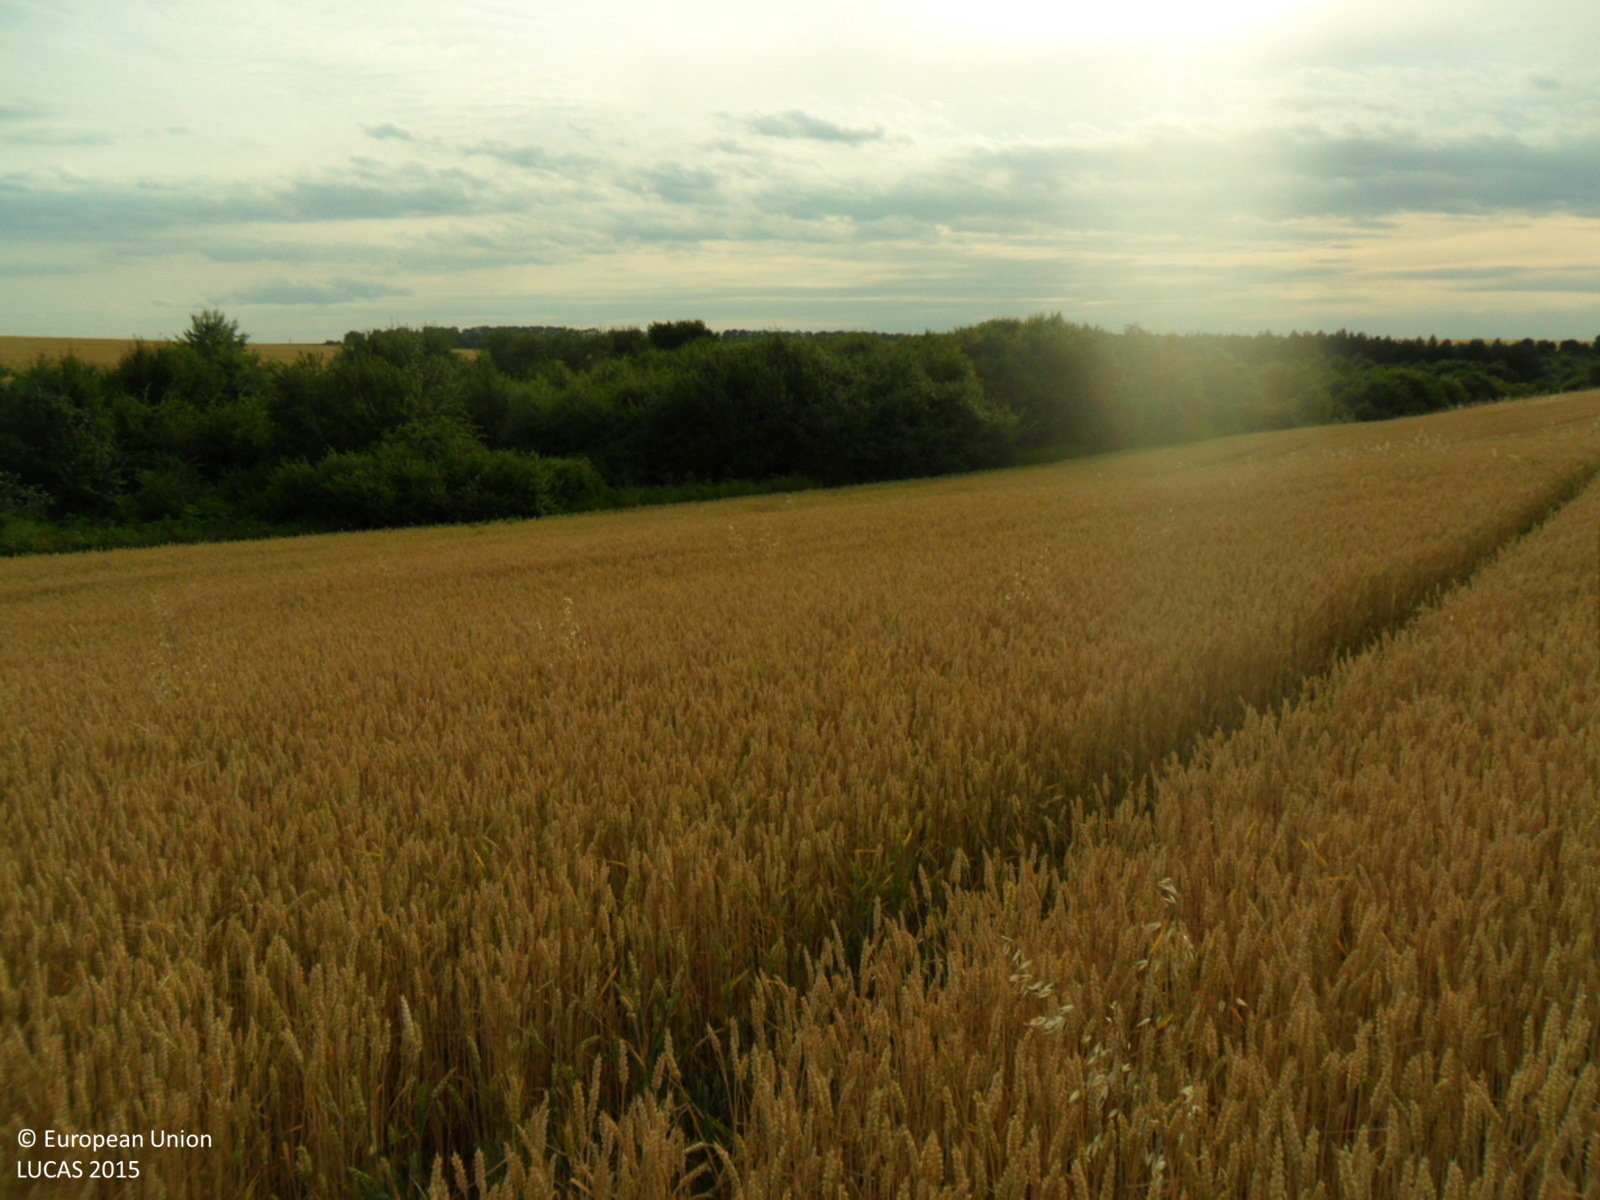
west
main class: Cropland
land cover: Common wheat
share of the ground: > 75 %
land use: Agriculture (excluding fallow land and kitchen gardens)
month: June
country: BG
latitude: 43.5795
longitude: 26.6668
